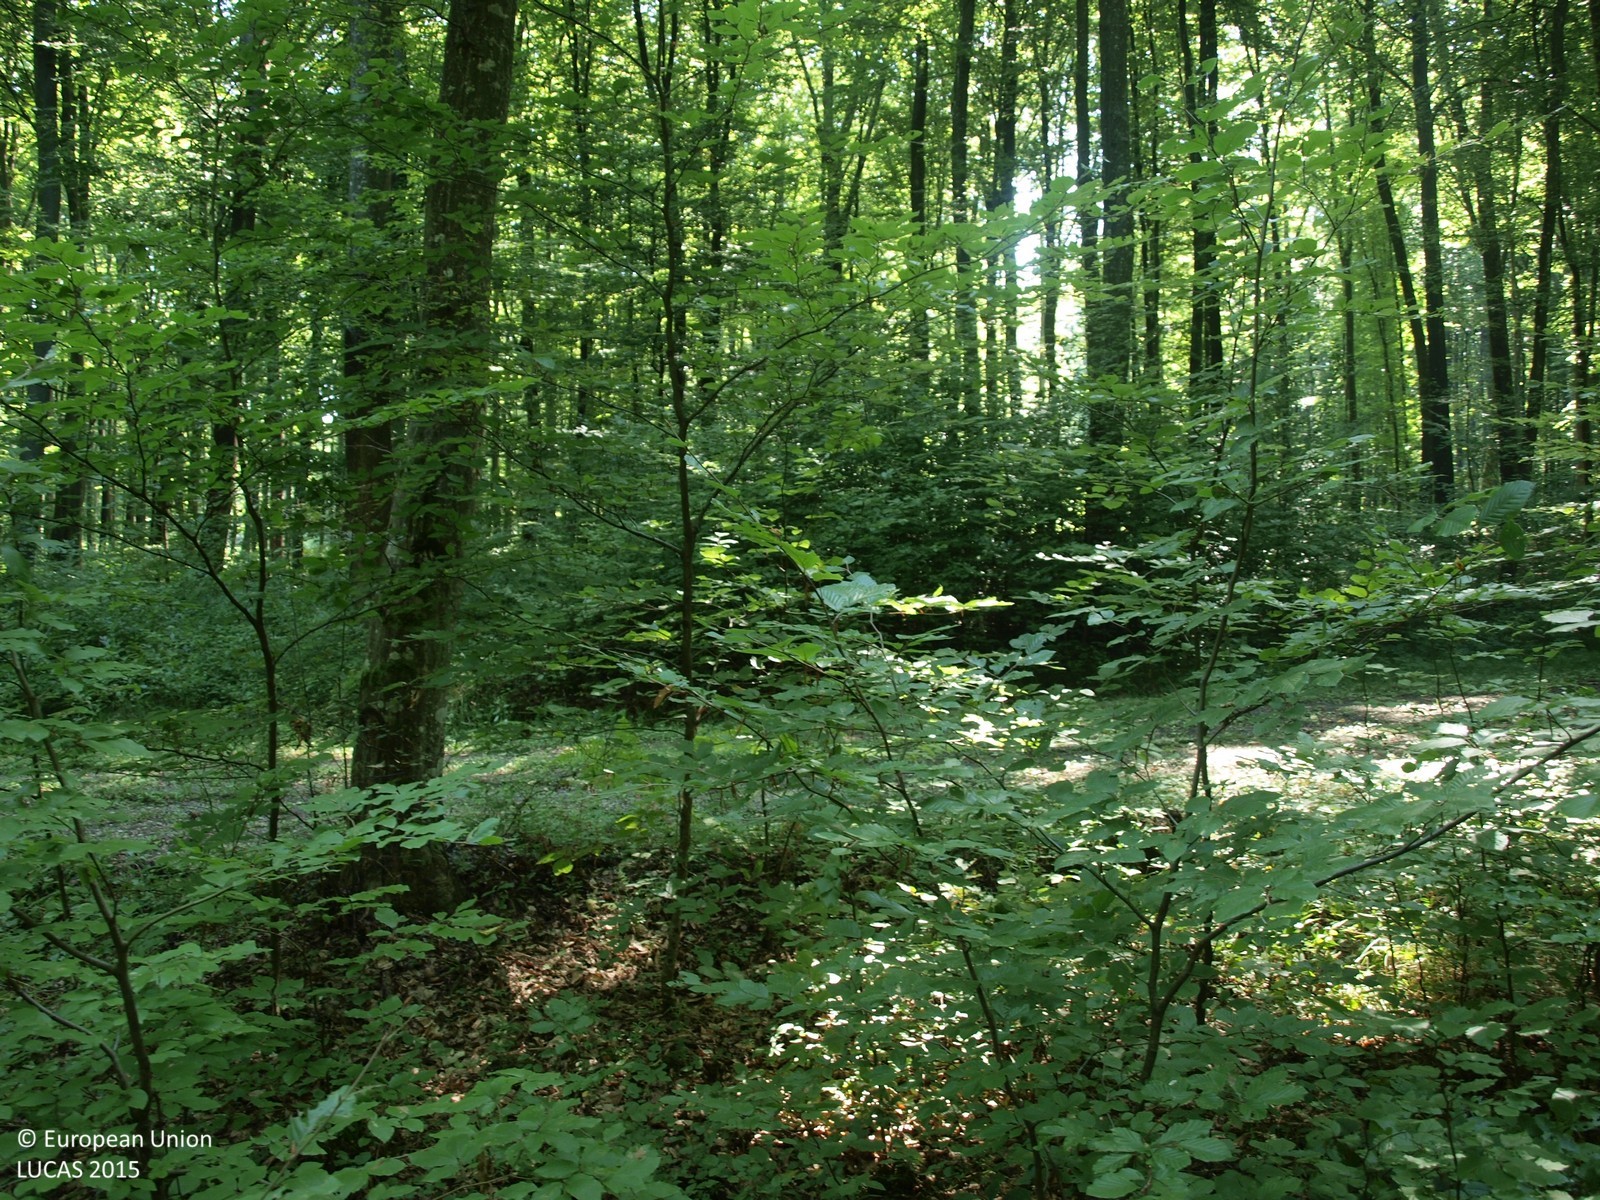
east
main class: Woodland
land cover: Broadleaved woodland
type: mesophytic deciduous forest
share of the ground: > 75 %
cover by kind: broadleaved forest trees 100 %
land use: Forestry
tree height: > 5 m
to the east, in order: Broadleaved woodland; Tracks; Broadleaved woodland
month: August
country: HR
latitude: 45.9327
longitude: 16.5642
